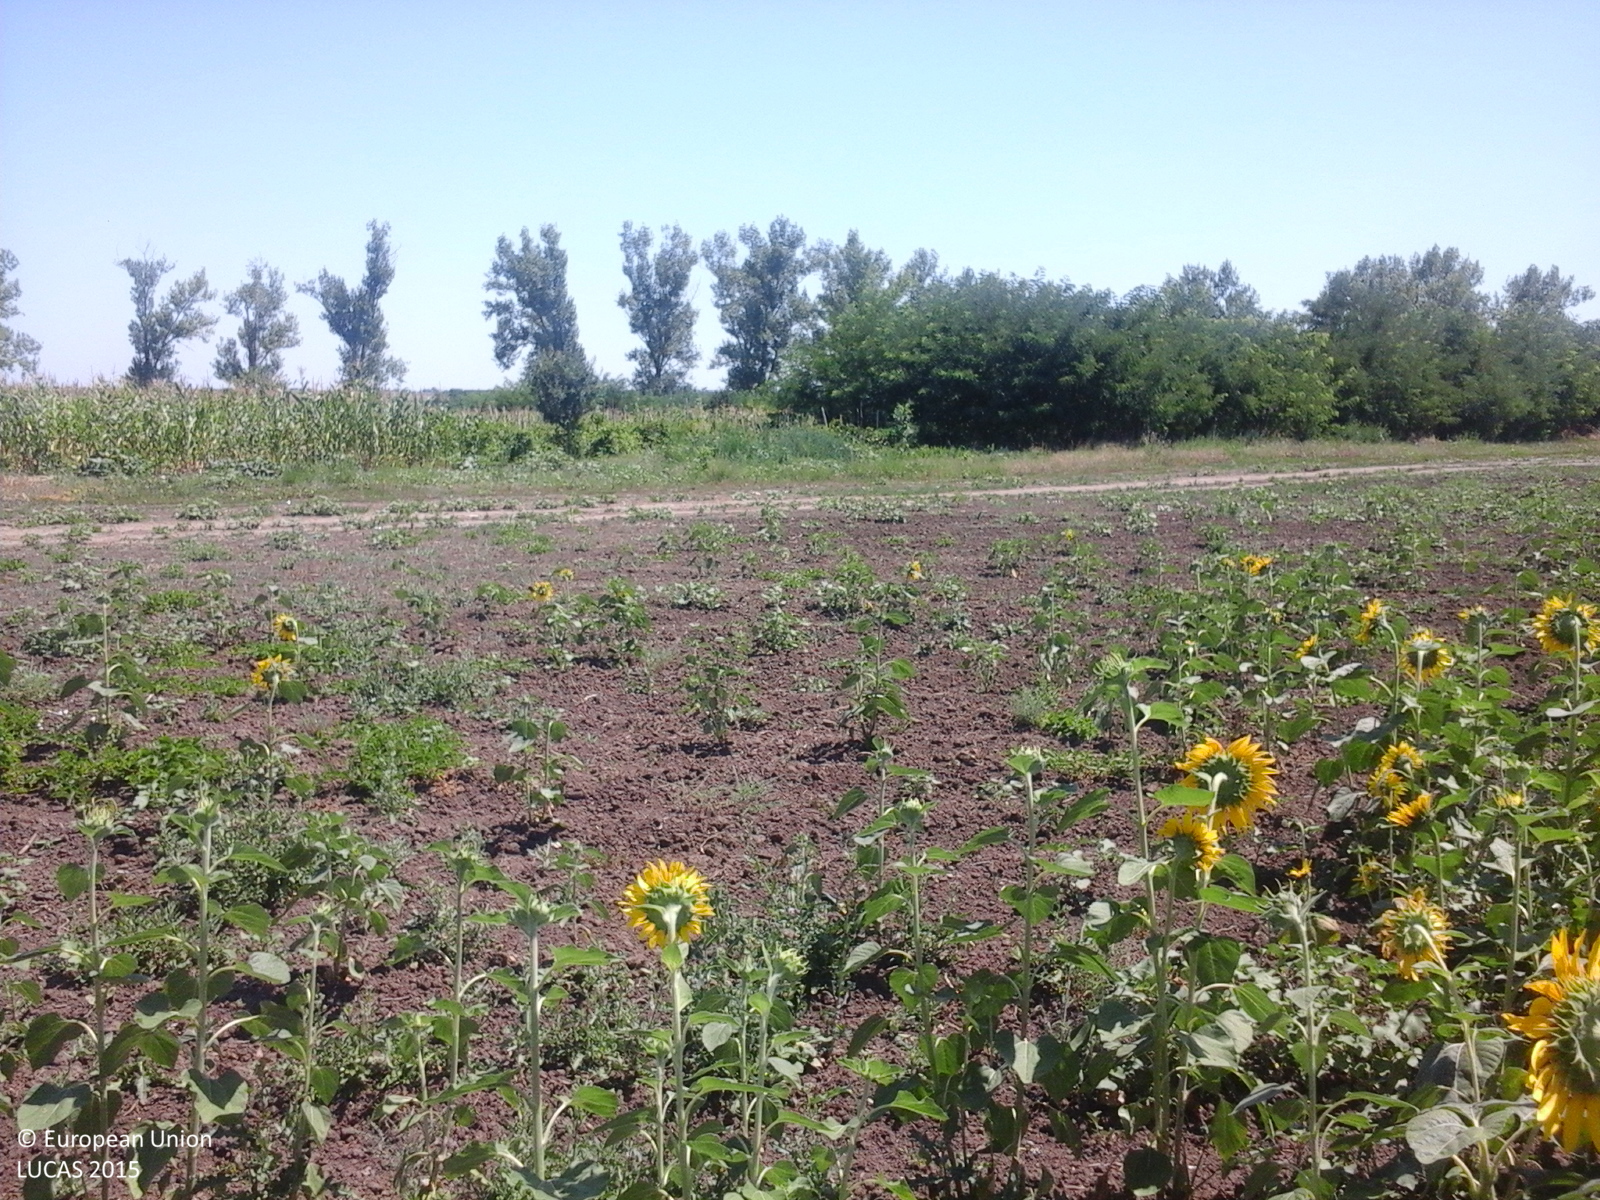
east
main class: Cropland
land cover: Sunflower
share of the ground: > 75 %
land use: Agriculture (excluding fallow land and kitchen gardens)
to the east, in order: Sunflower; Tracks; Vineyards; Maize; Vineyards; Maize; Vineyards; Broadleaved woodland
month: July
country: RO
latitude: 44.2546
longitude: 26.5850
